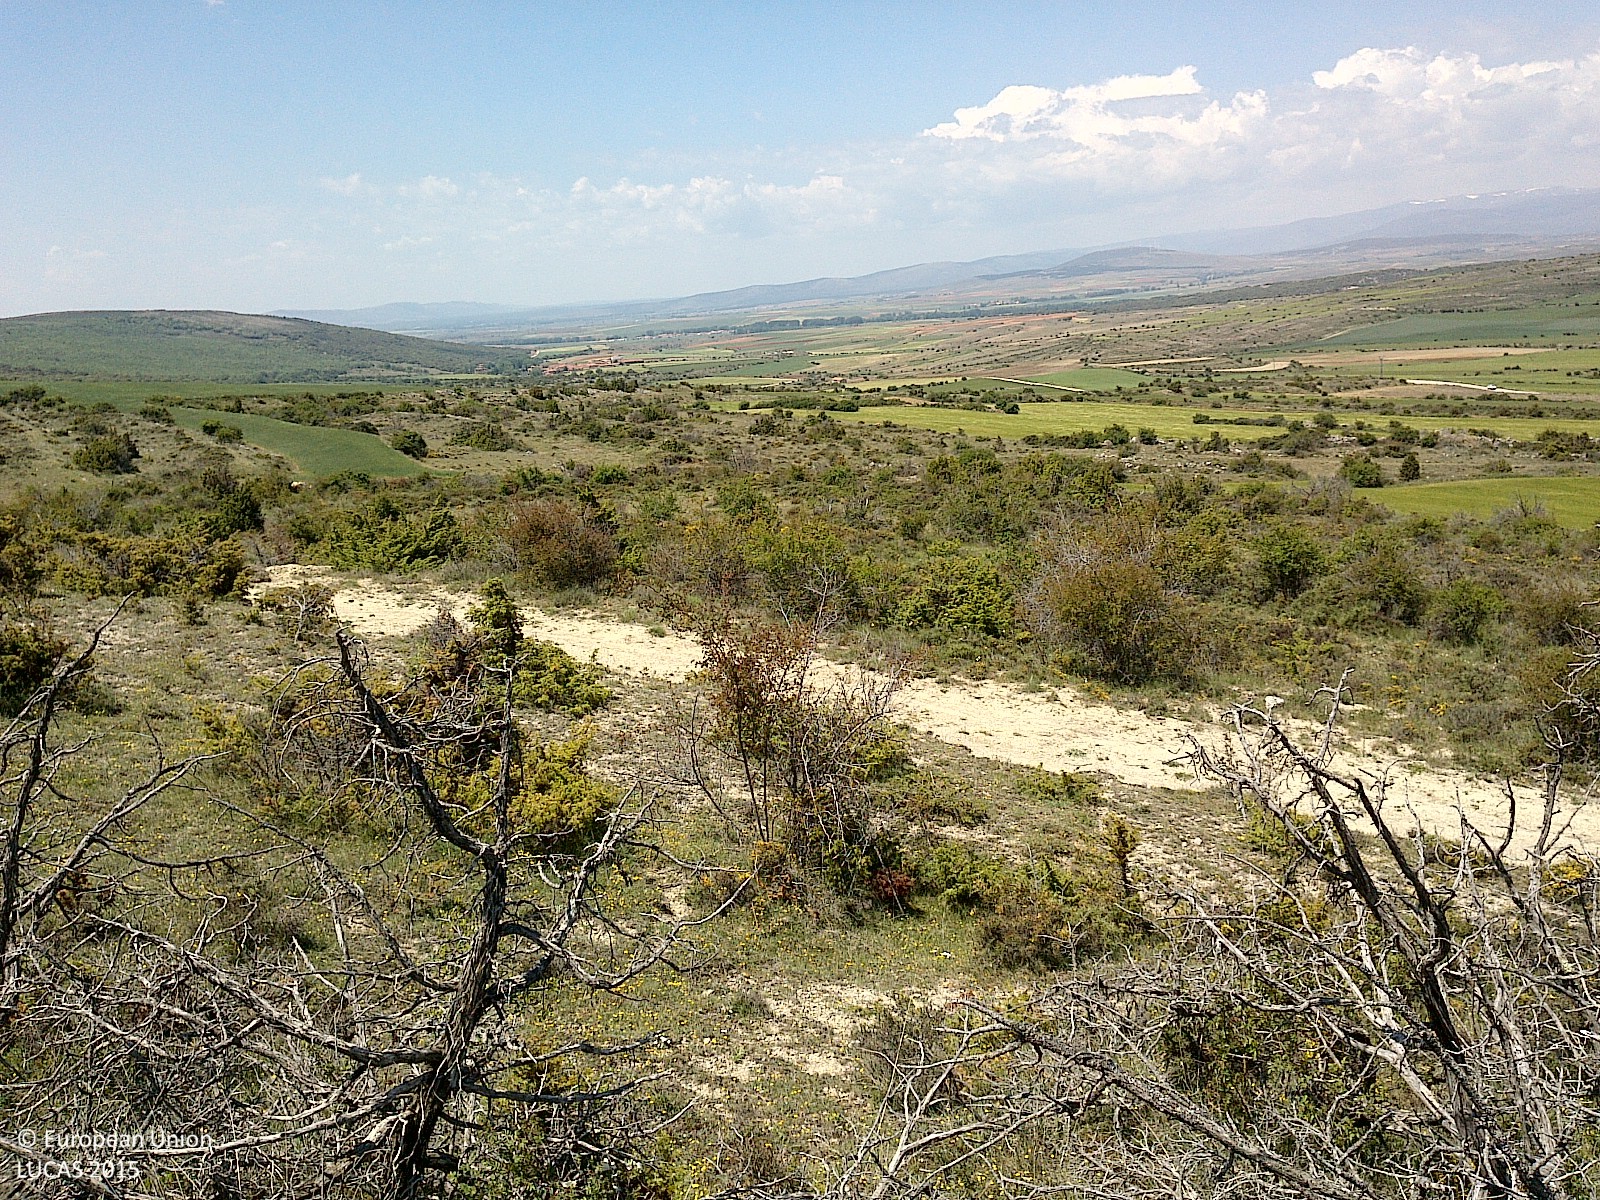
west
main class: Shrubland
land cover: Shrubland with sparse tree cover
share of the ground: 50 - 75 %
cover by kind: shrubs 55 %, herbaceous plants 20 %, consolidated bare surface 20 %, coniferous forest trees 5 %
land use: Semi-natural and natural areas not in use
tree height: < 5 m
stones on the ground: < 10 %
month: May
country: ES
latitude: 41.8512
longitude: -2.2620
